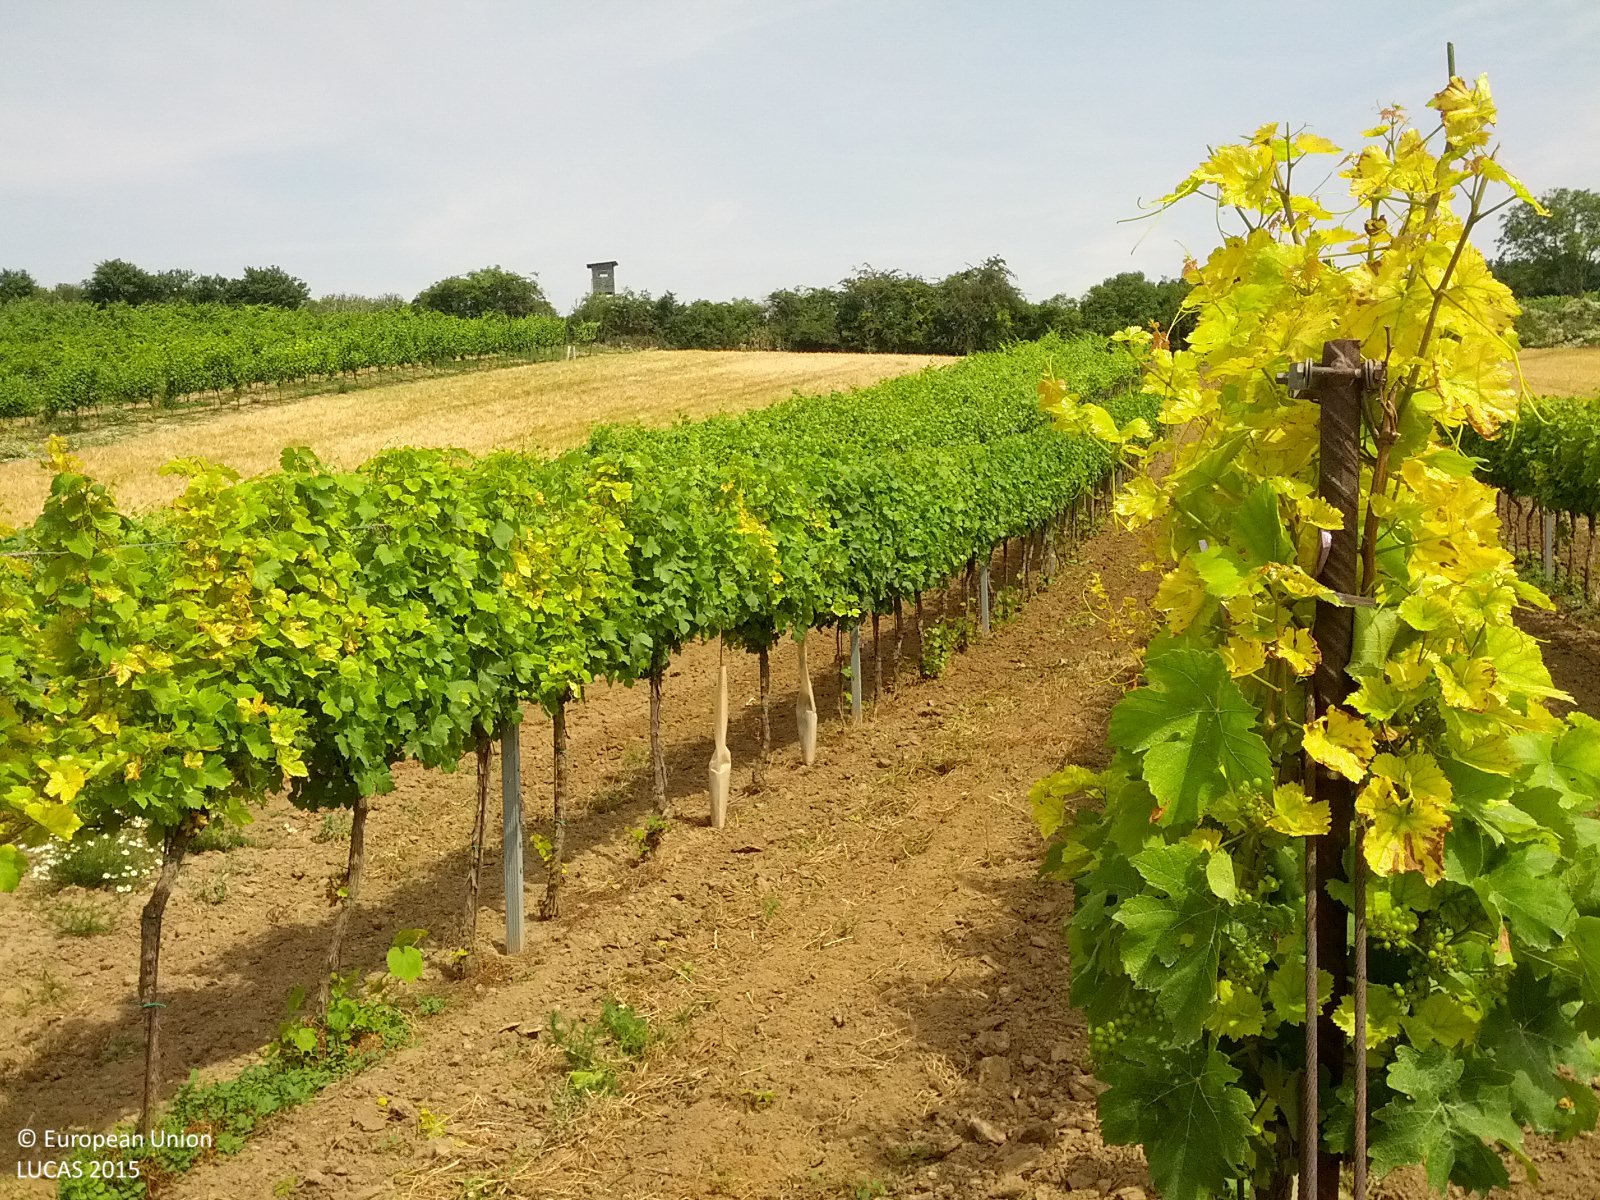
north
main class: Cropland
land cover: Vineyards
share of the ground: 10 - 25 %
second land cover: Other bare soil
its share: > 75 %
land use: Agriculture (excluding fallow land and kitchen gardens)
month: June
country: AT
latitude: 48.7053
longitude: 16.7064
